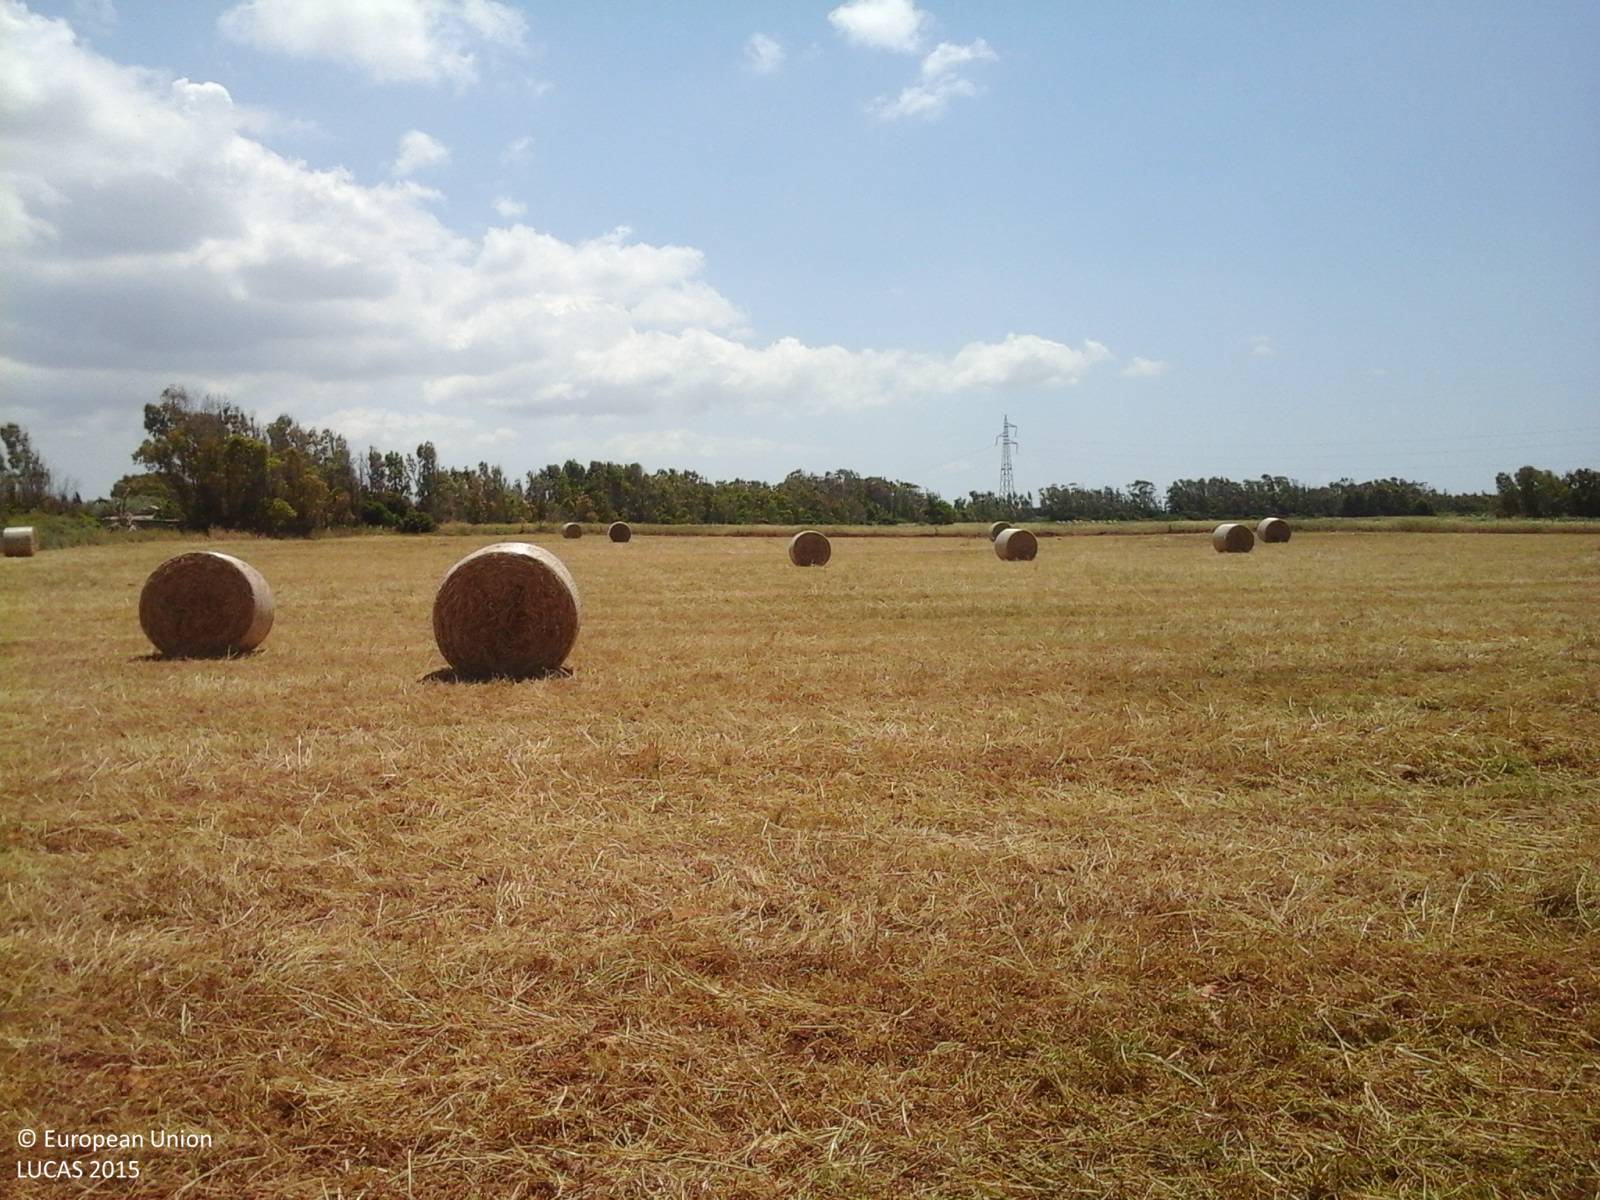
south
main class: Grassland
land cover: Grassland without tree/shrub cover
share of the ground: > 75 %
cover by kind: herbaceous plants 100 %
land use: Agriculture (excluding fallow land and kitchen gardens)
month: May
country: IT
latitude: 40.7605
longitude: 8.3613
